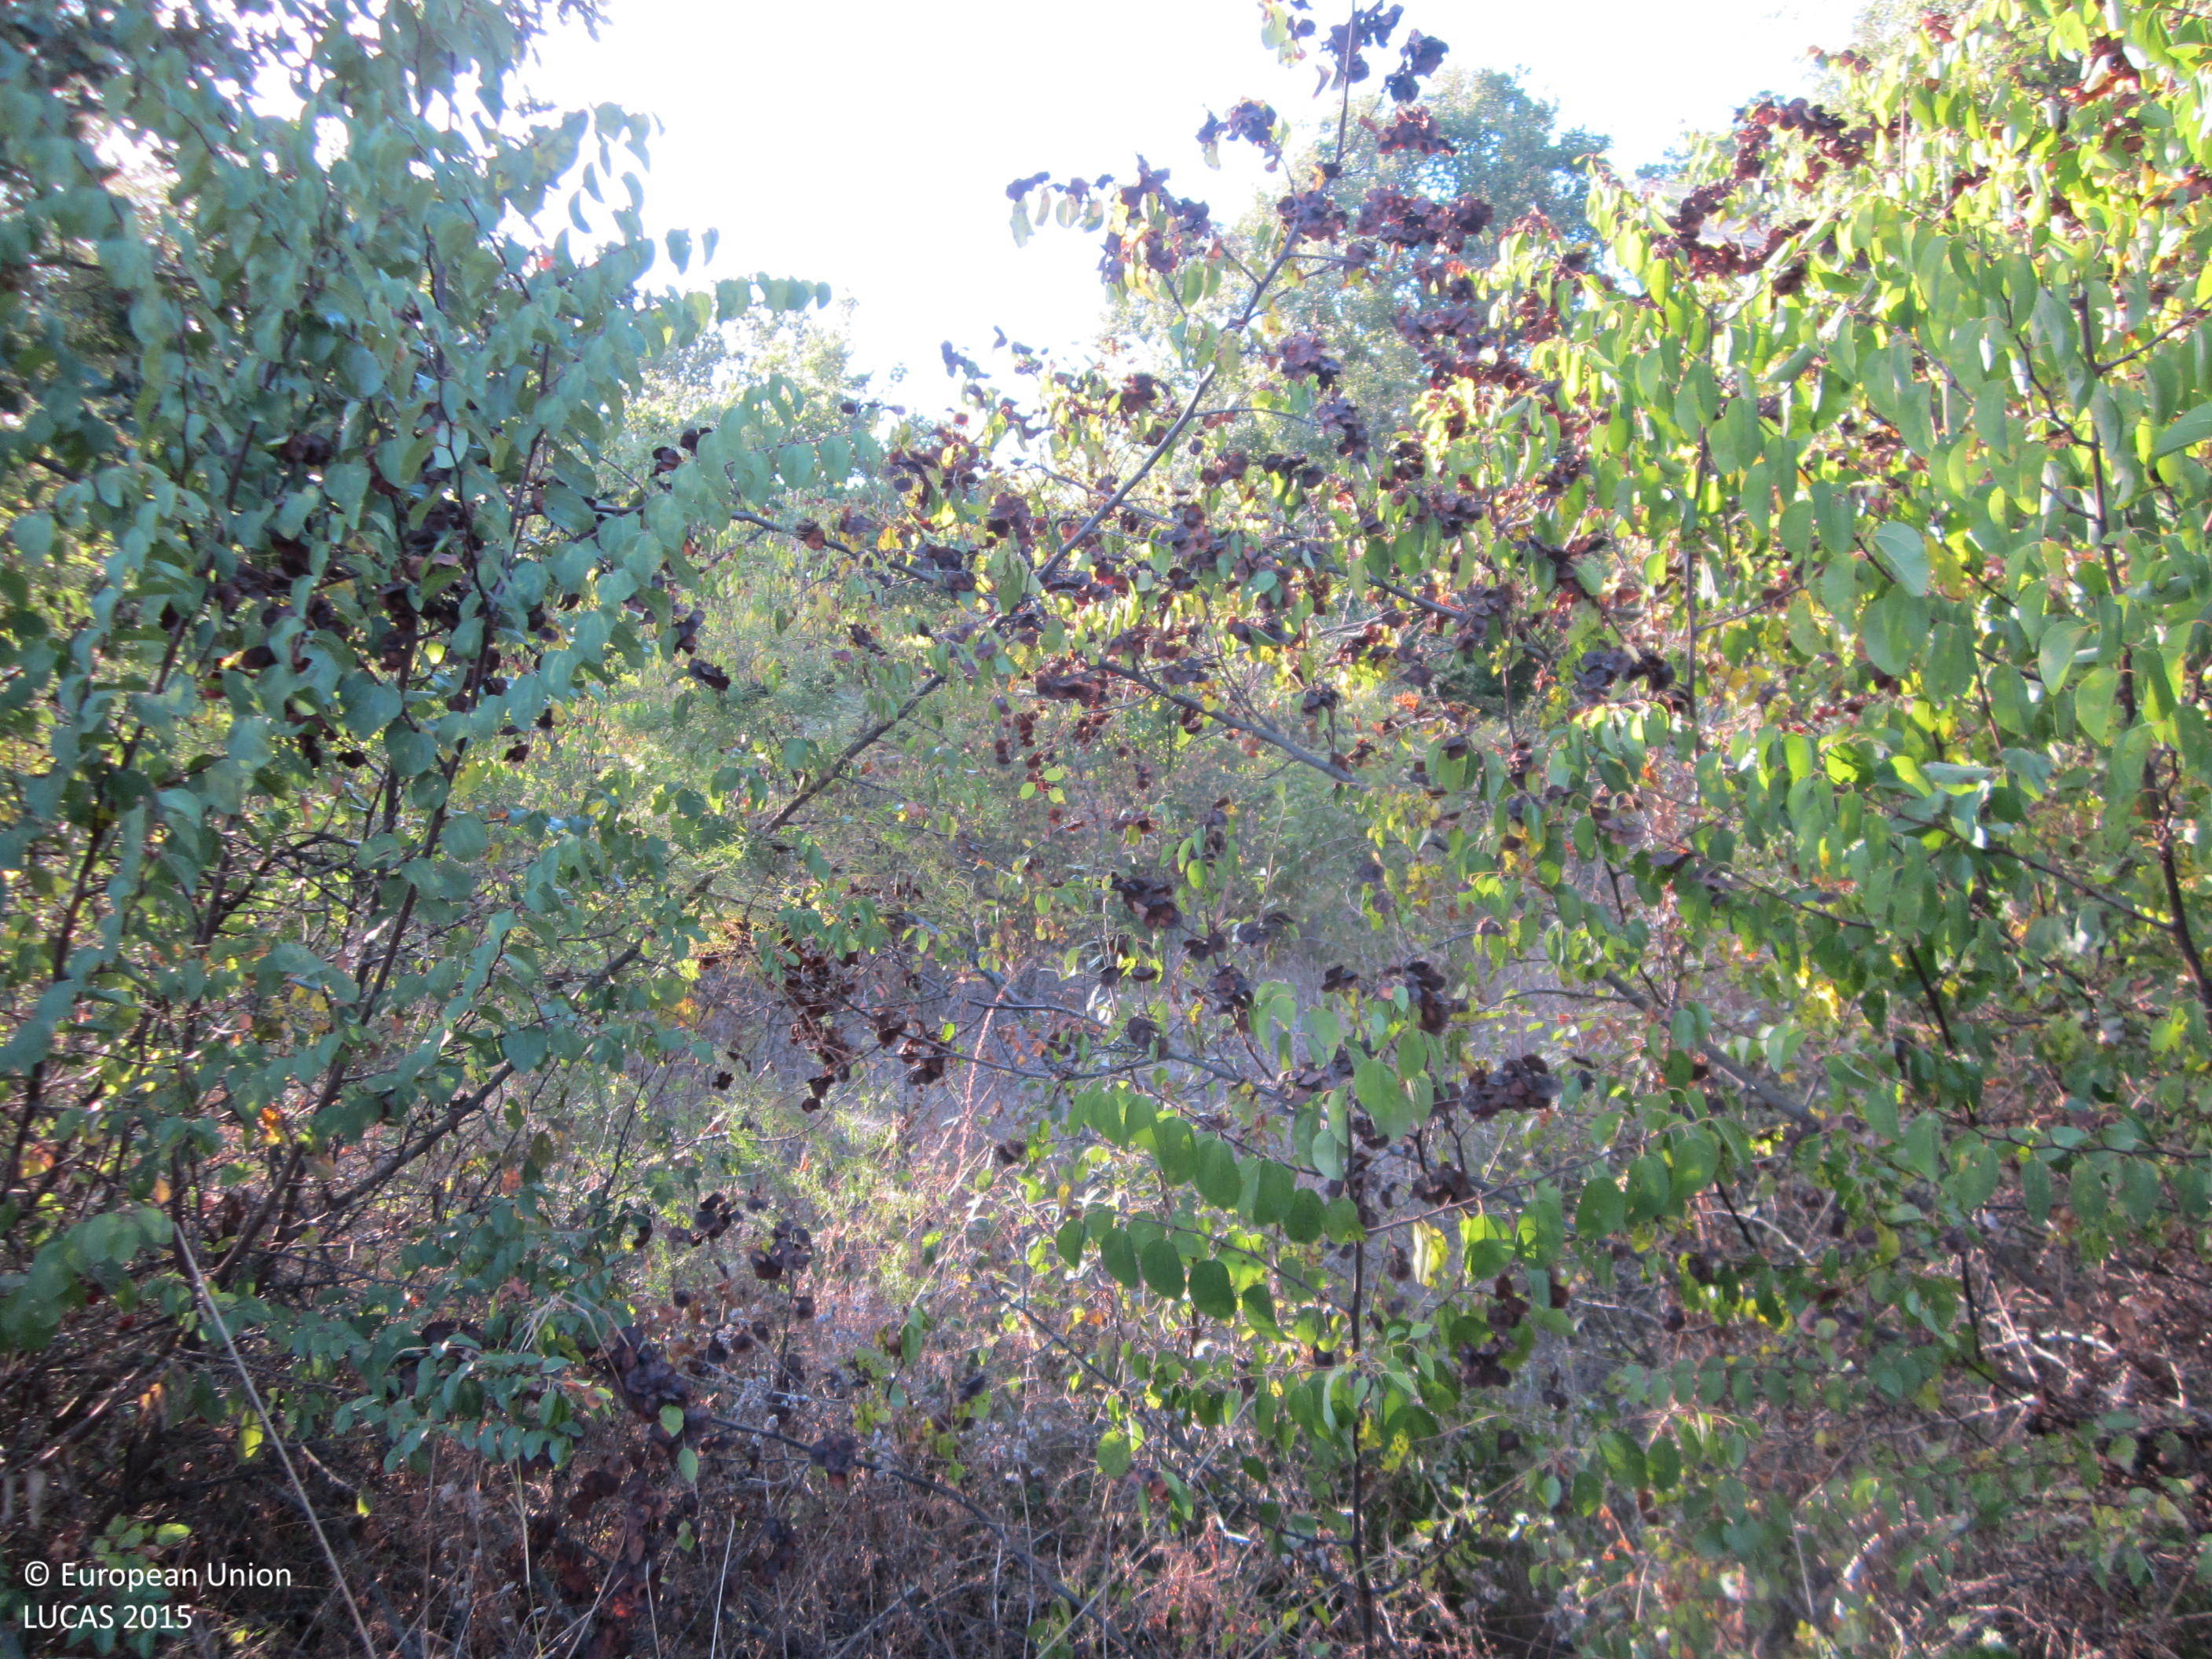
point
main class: Shrubland
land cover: Shrubland with sparse tree cover
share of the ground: > 75 %
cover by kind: shrubs 80 %, herbaceous plants 15 %, broadleaved forest trees 5 %
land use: Semi-natural and natural areas not in use
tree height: < 5 m
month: September
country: BG
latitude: 42.6630
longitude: 27.4053
